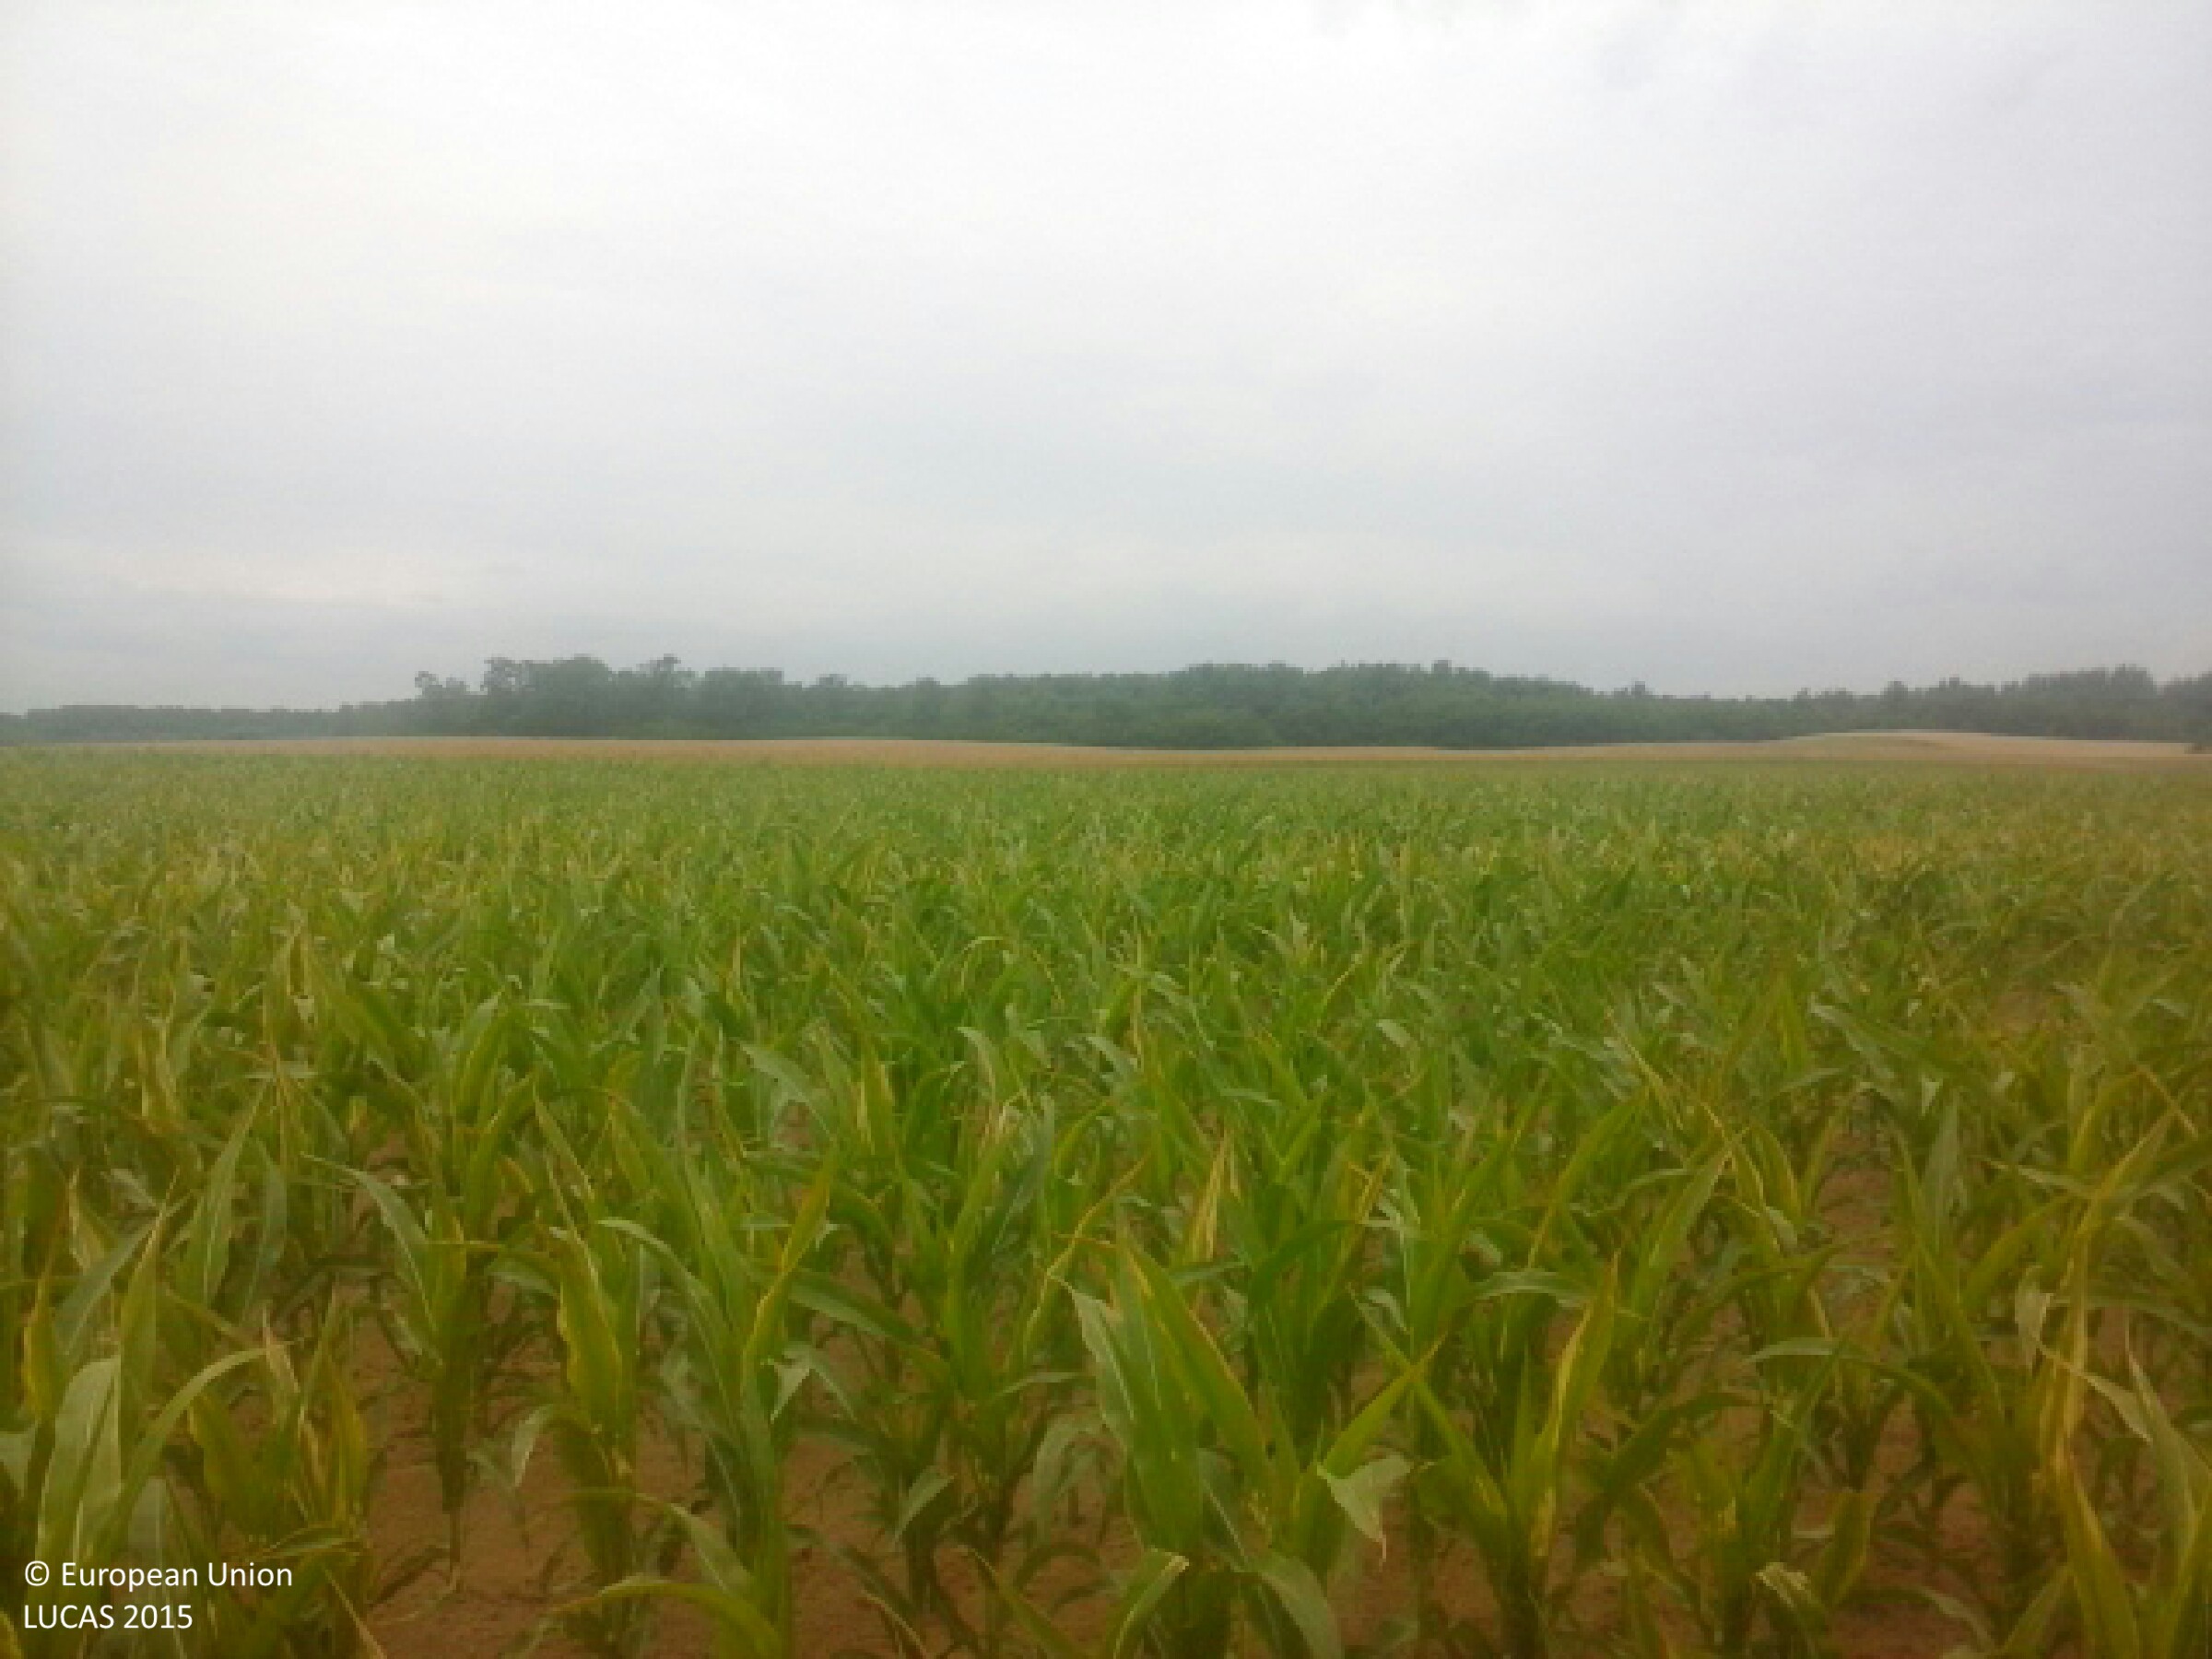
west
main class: Cropland
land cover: Maize
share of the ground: 25 - 50 %
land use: Agriculture (excluding fallow land and kitchen gardens)
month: June
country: HU
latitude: 47.9524
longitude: 22.1182
